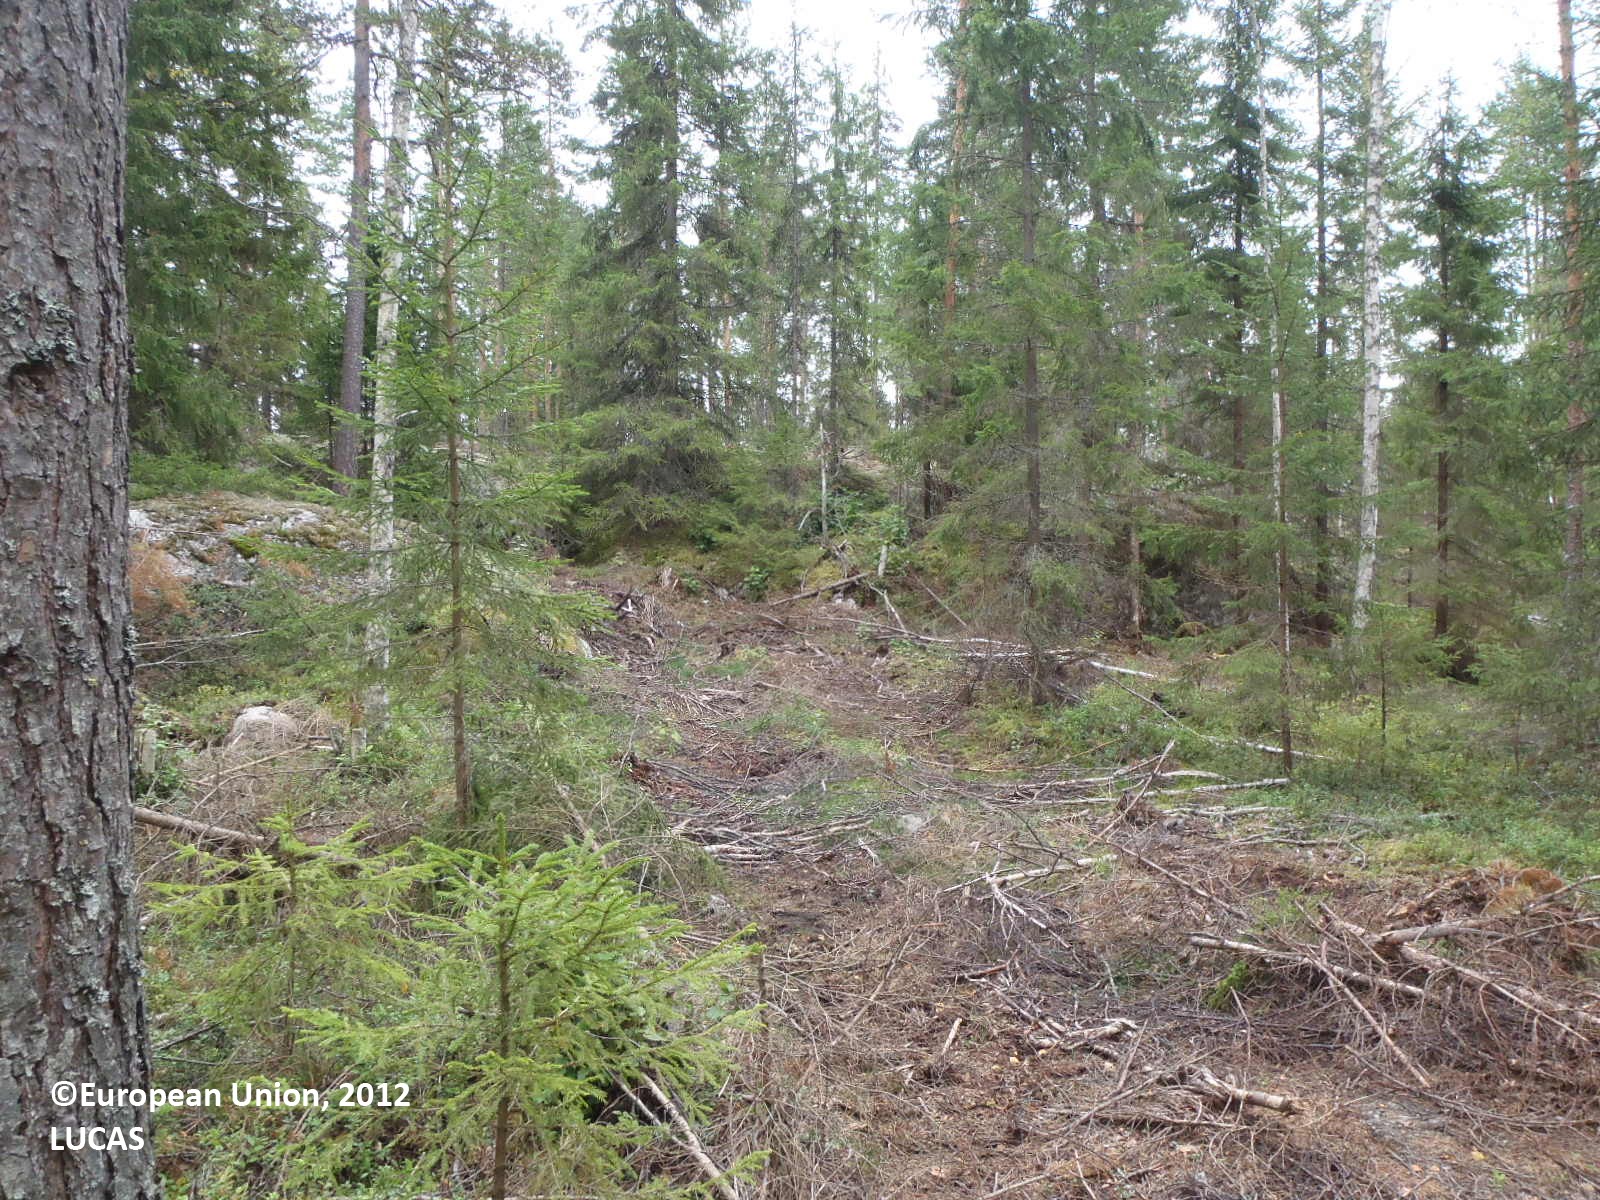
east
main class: Woodland
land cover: Pine dominated mixed woodland
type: boreal forest
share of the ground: > 75 %
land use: Forestry
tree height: > 5 m
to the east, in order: Pine dominated mixed woodland; Pine dominated coniferous woodland; Ditches and canals; Pine dominated mixed woodland; Ditches and canals; Pine dominated coniferous woodland; Grass margins; Paved roads, cycling and walking lanes; Grassland without tree/shrub cover; Ditches and canals; Pine dominated coniferous woodland
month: August
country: FI
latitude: 60.8145
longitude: 22.4396
